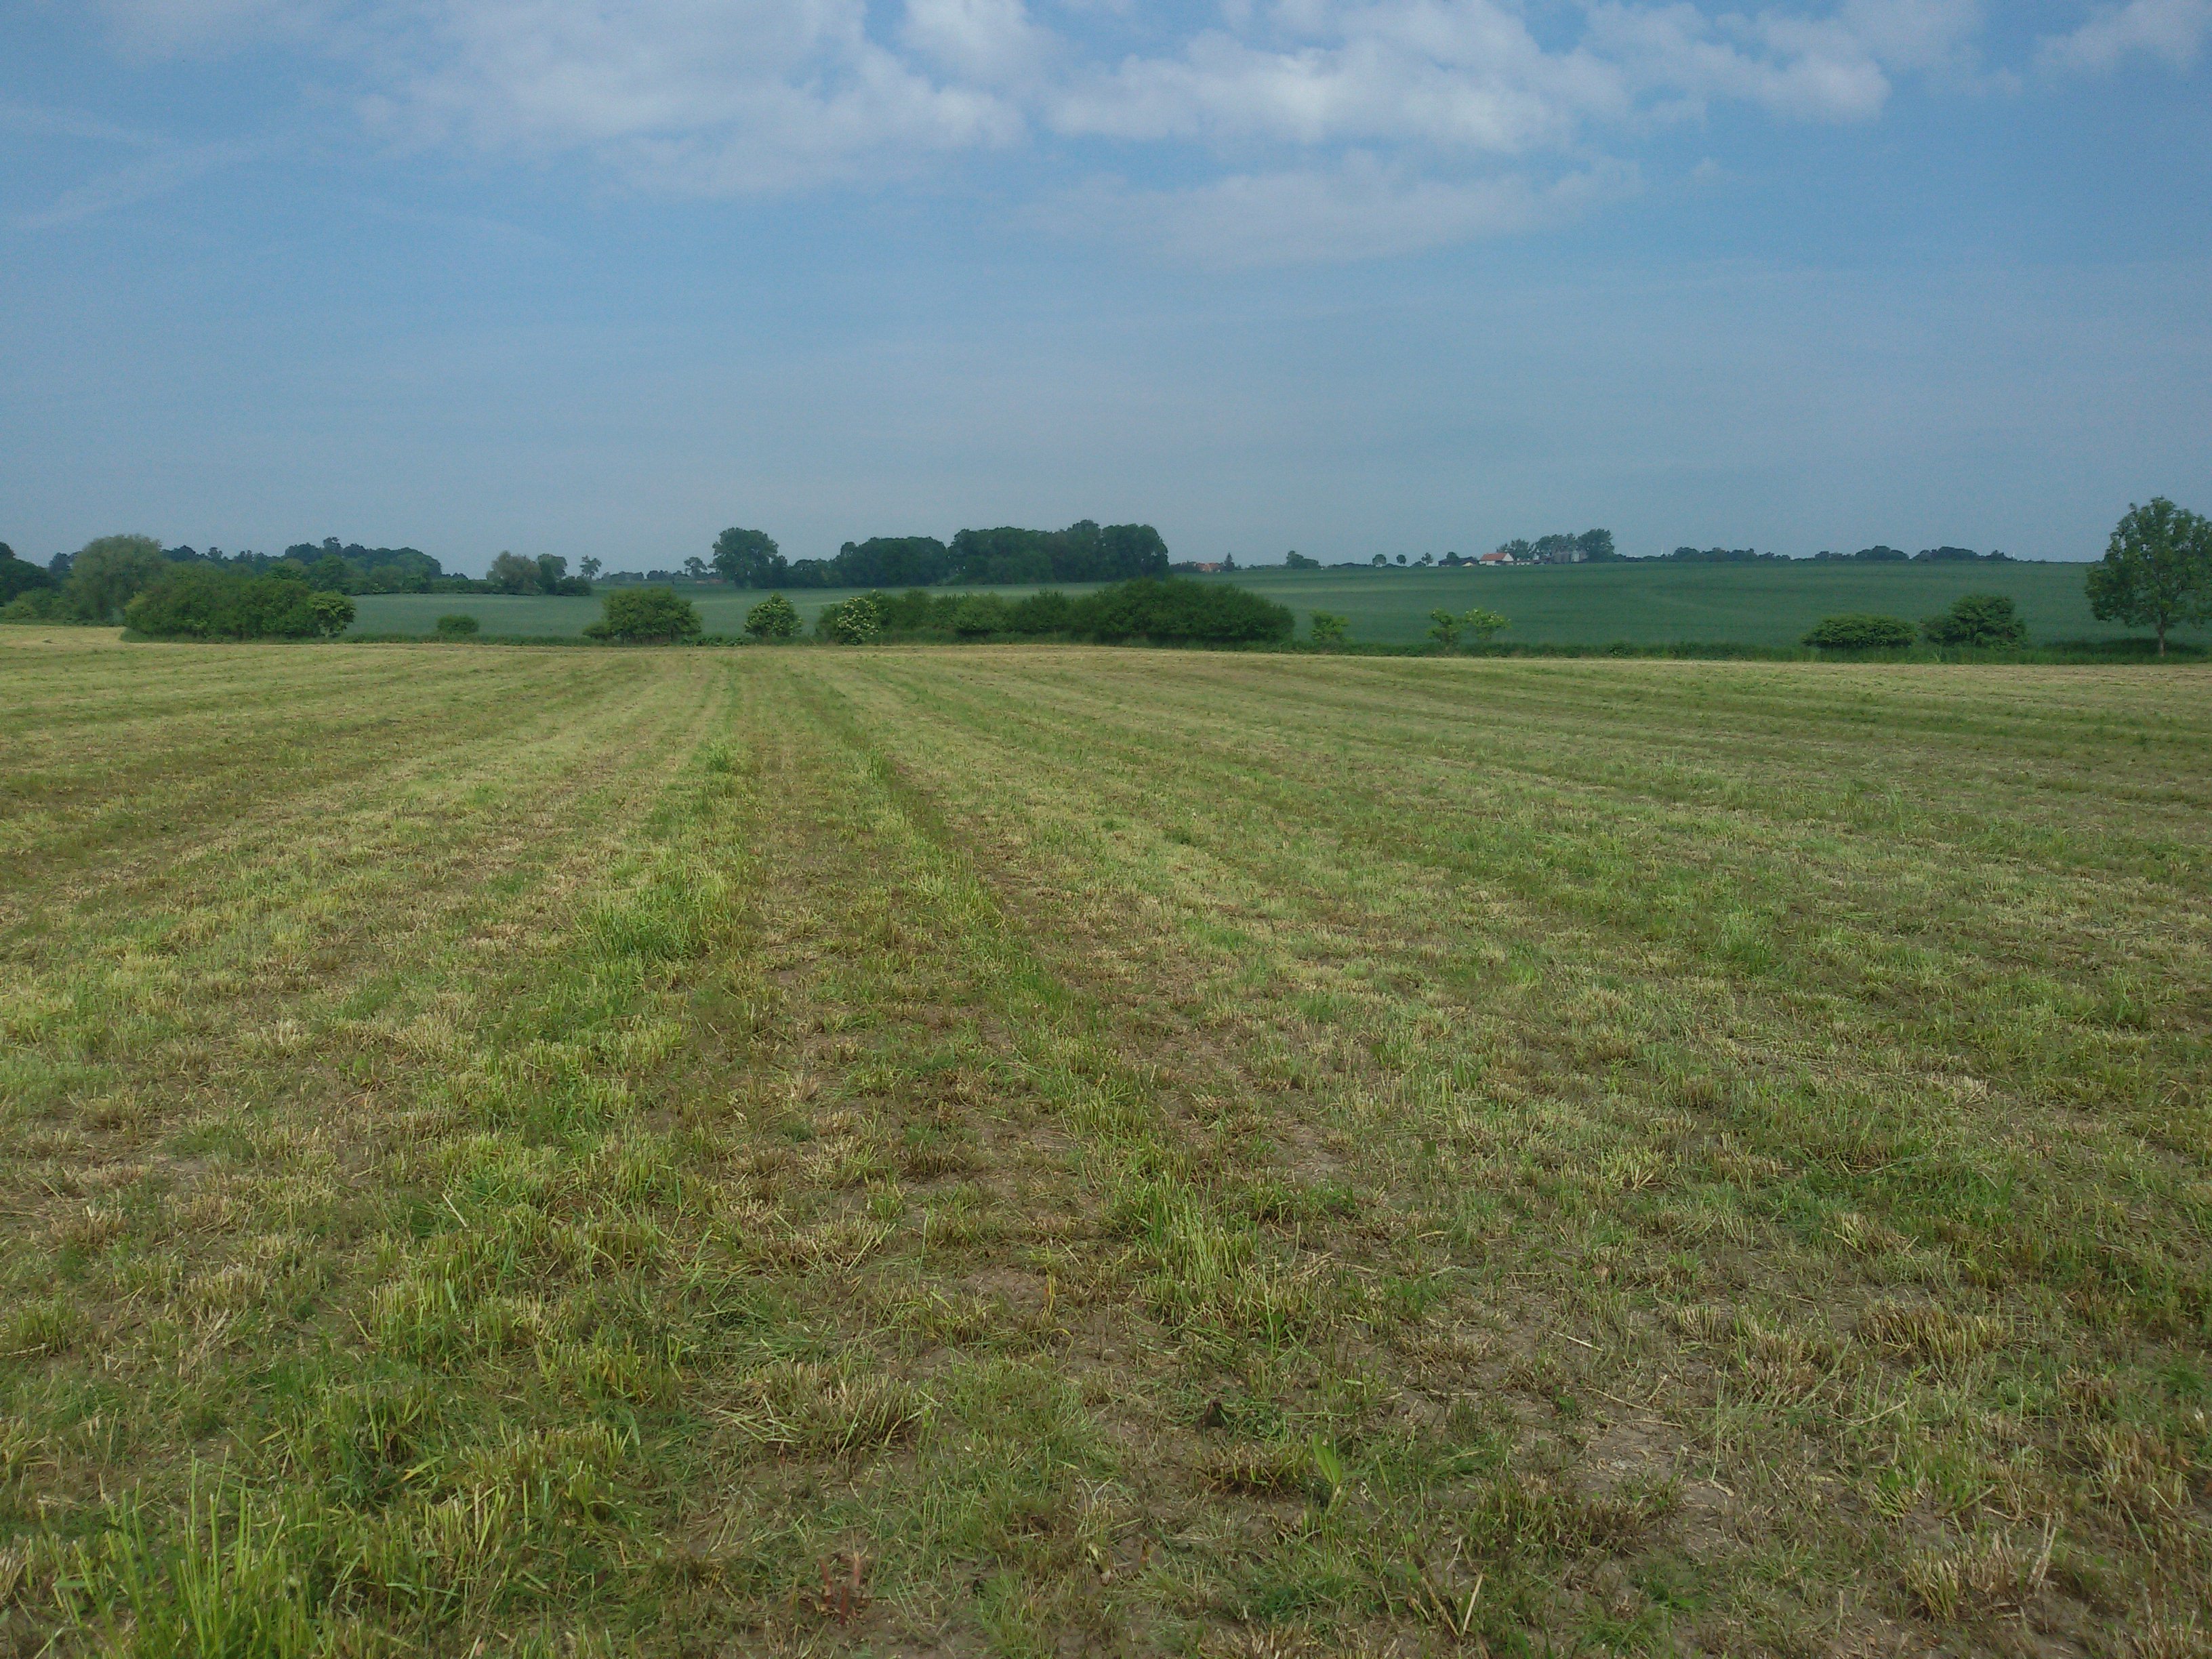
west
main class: Cropland
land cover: Temporary grasslands
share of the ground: > 75 %
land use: Agriculture (excluding fallow land and kitchen gardens)
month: May
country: PL
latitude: 50.4989
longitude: 17.1868
